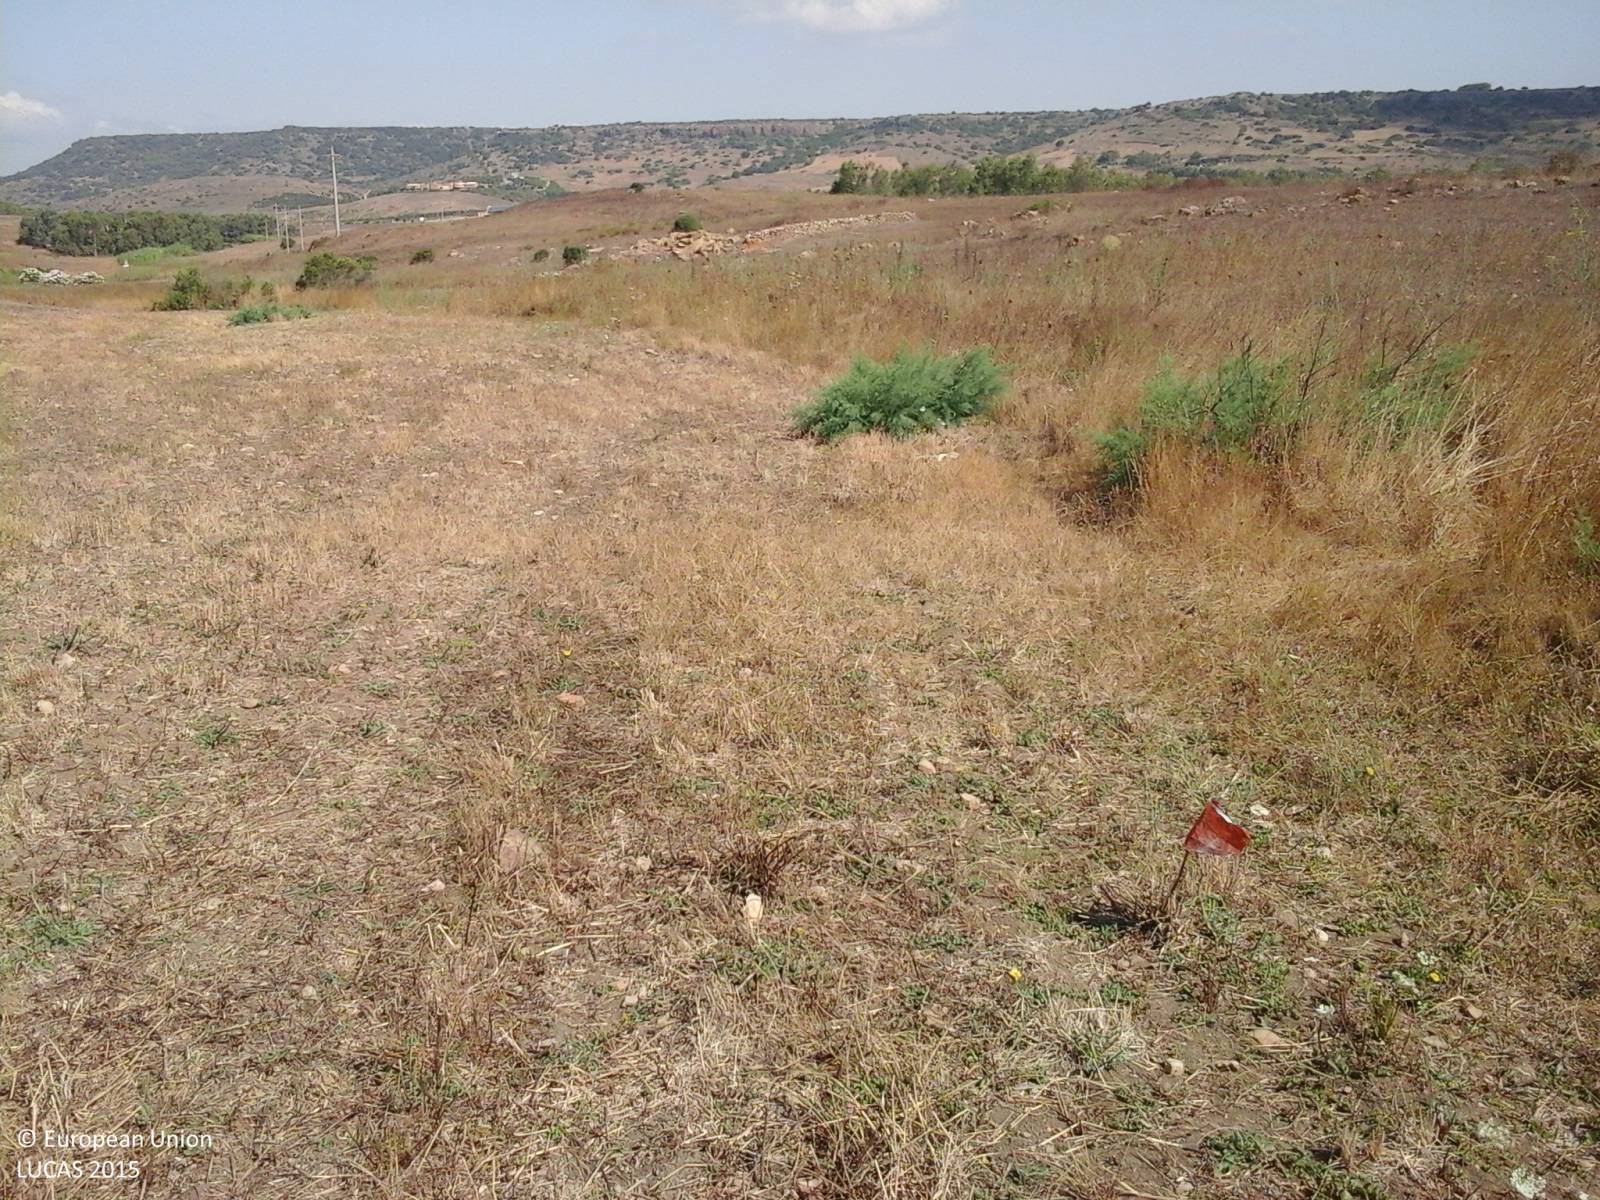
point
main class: Grassland
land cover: Spontaneously vegetated surfaces
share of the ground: > 75 %
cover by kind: herbaceous plants 100 %
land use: Agriculture (excluding fallow land and kitchen gardens)
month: July
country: IT
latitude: 39.6452
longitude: 8.8762
